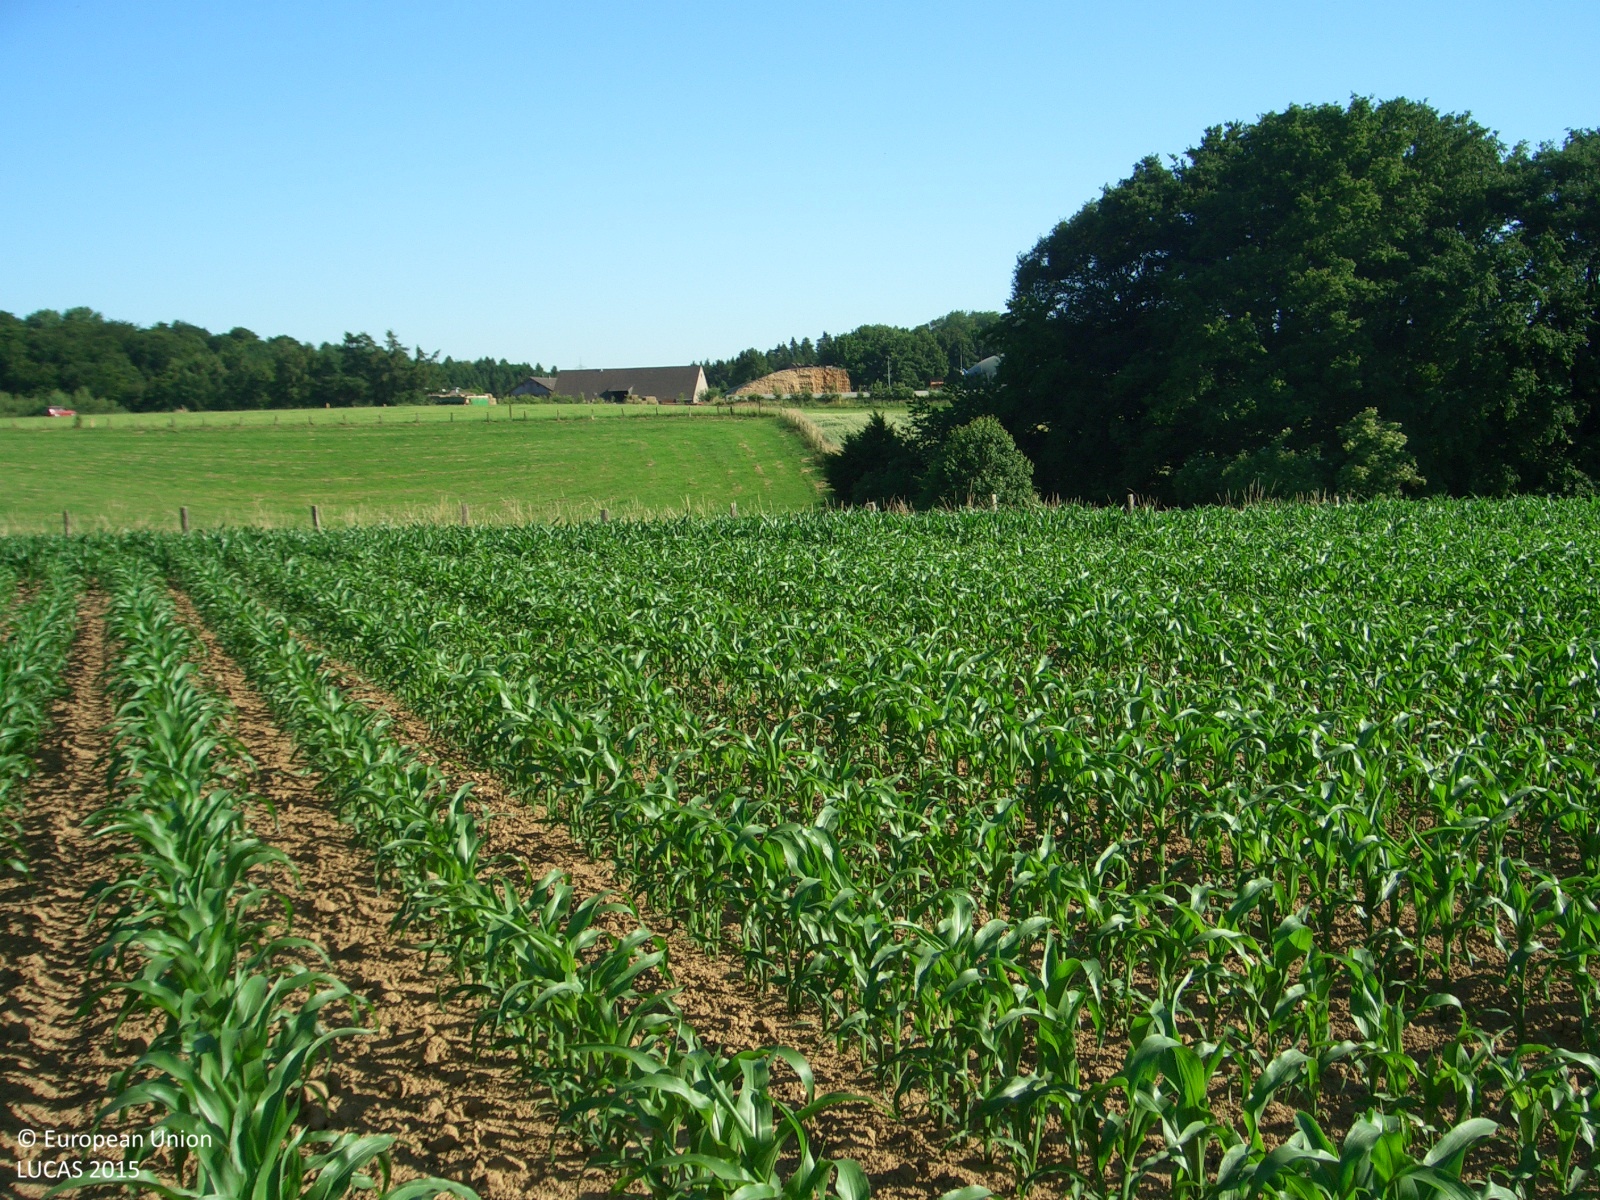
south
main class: Cropland
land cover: Maize
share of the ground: 50 - 75 %
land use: Agriculture (excluding fallow land and kitchen gardens)
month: June
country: DE
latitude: 51.1175
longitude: 7.0428
